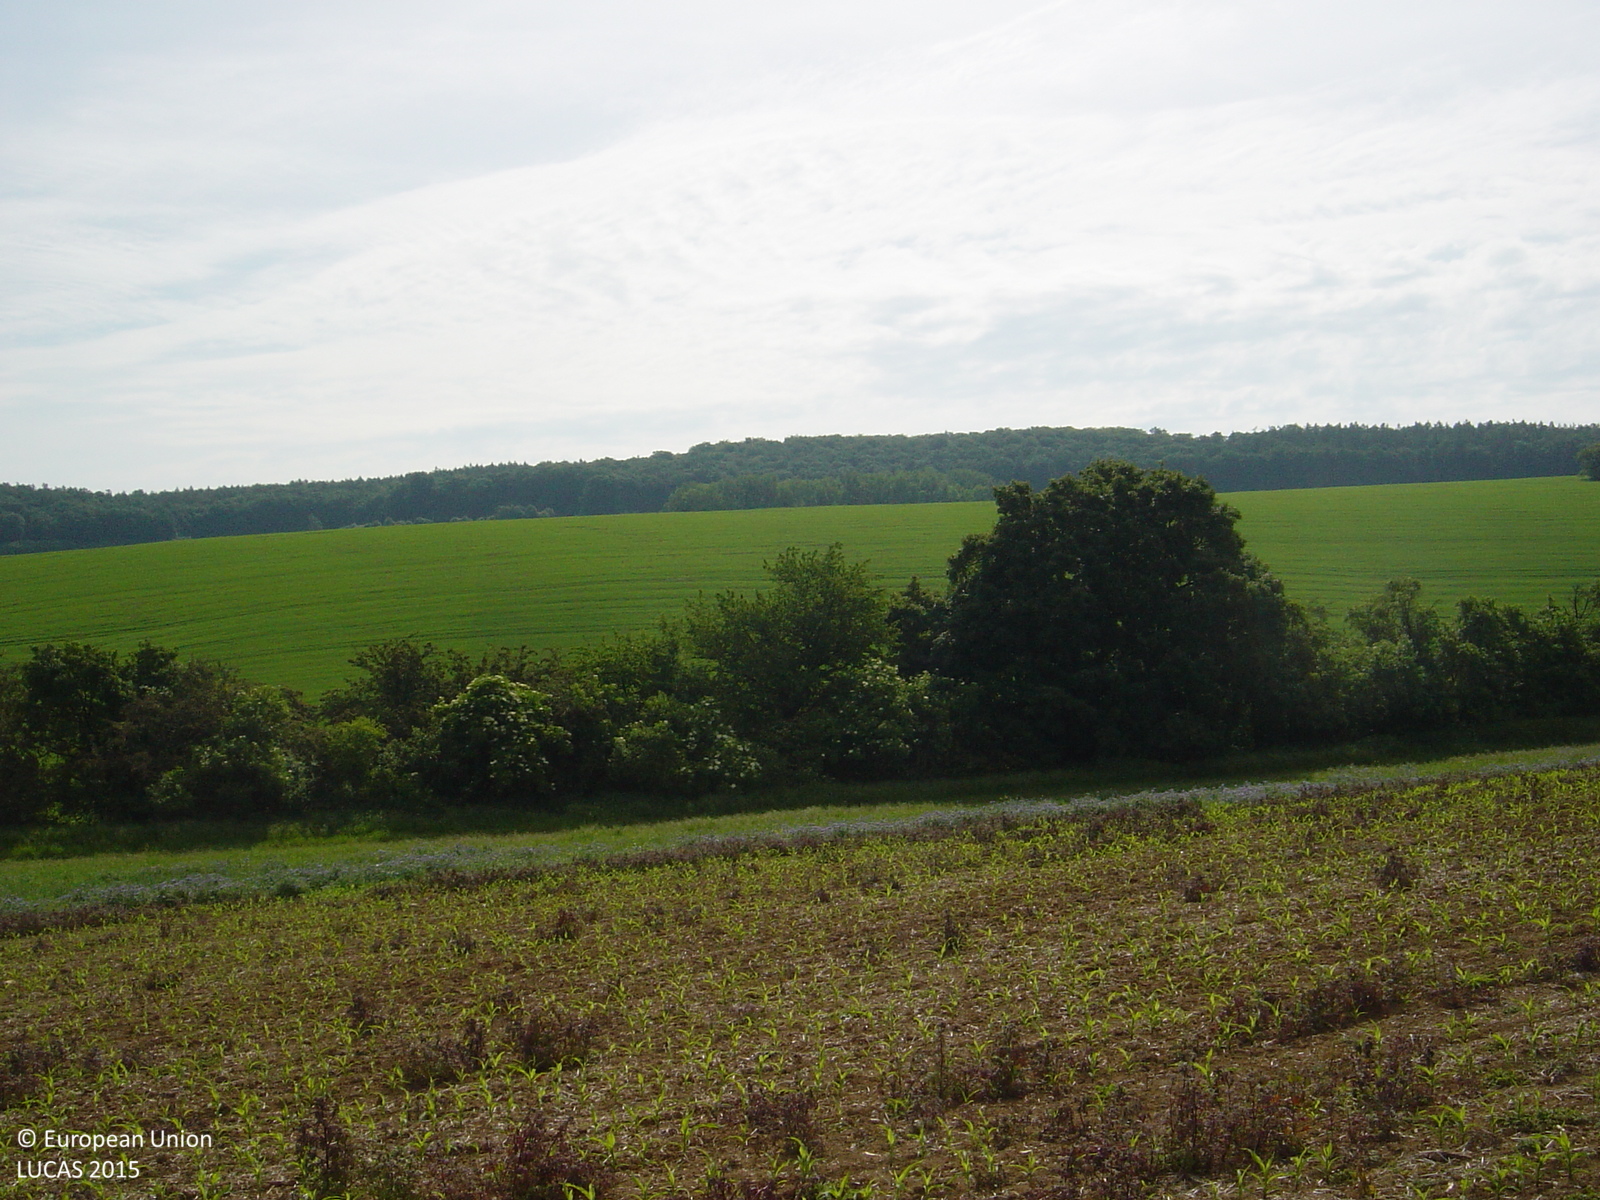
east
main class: Cropland
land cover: Maize
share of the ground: 10 - 25 %
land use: Agriculture (excluding fallow land and kitchen gardens)
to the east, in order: Maize; Dry pulses; Grass margins; Tracks; Grass margins; Shrubland with sparse tree cover; Barley
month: June
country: CZ
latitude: 49.1343
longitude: 17.0679
